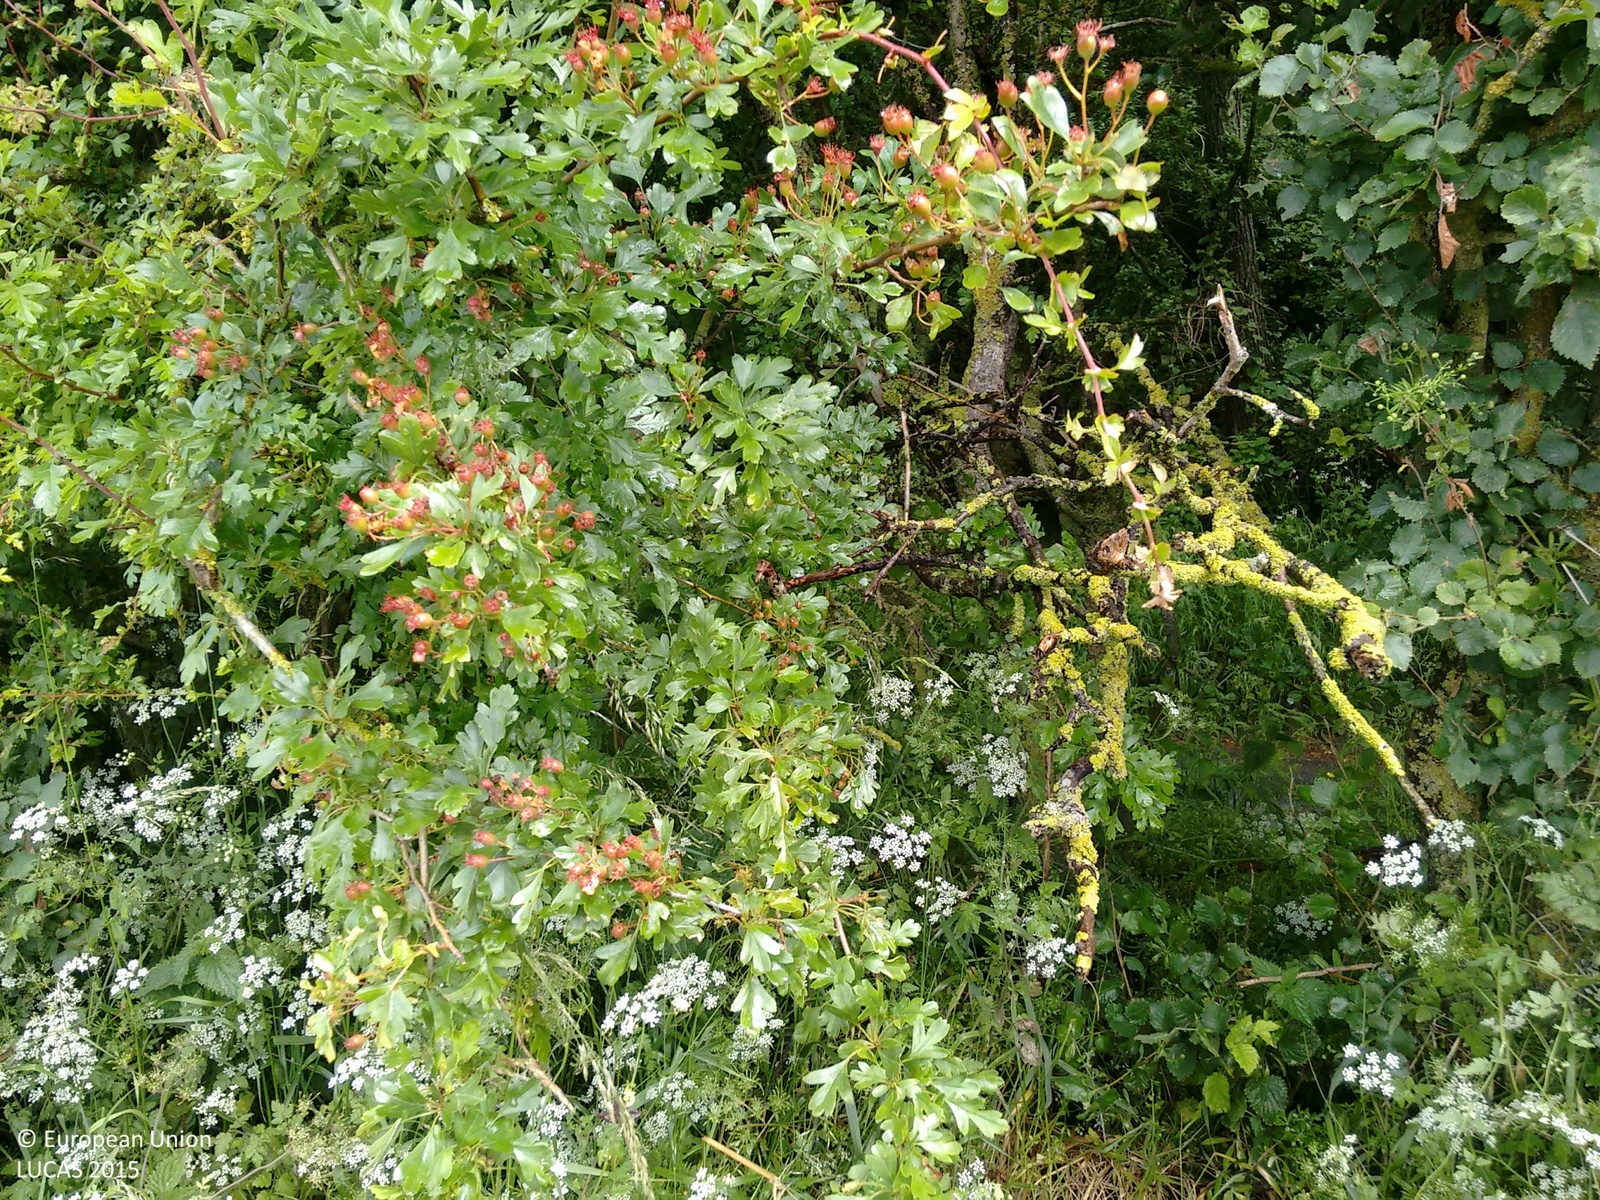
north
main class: Cropland
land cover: Common wheat
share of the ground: > 75 %
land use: Agriculture (excluding fallow land and kitchen gardens)
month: June
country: GB
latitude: 51.2985
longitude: -2.2970
